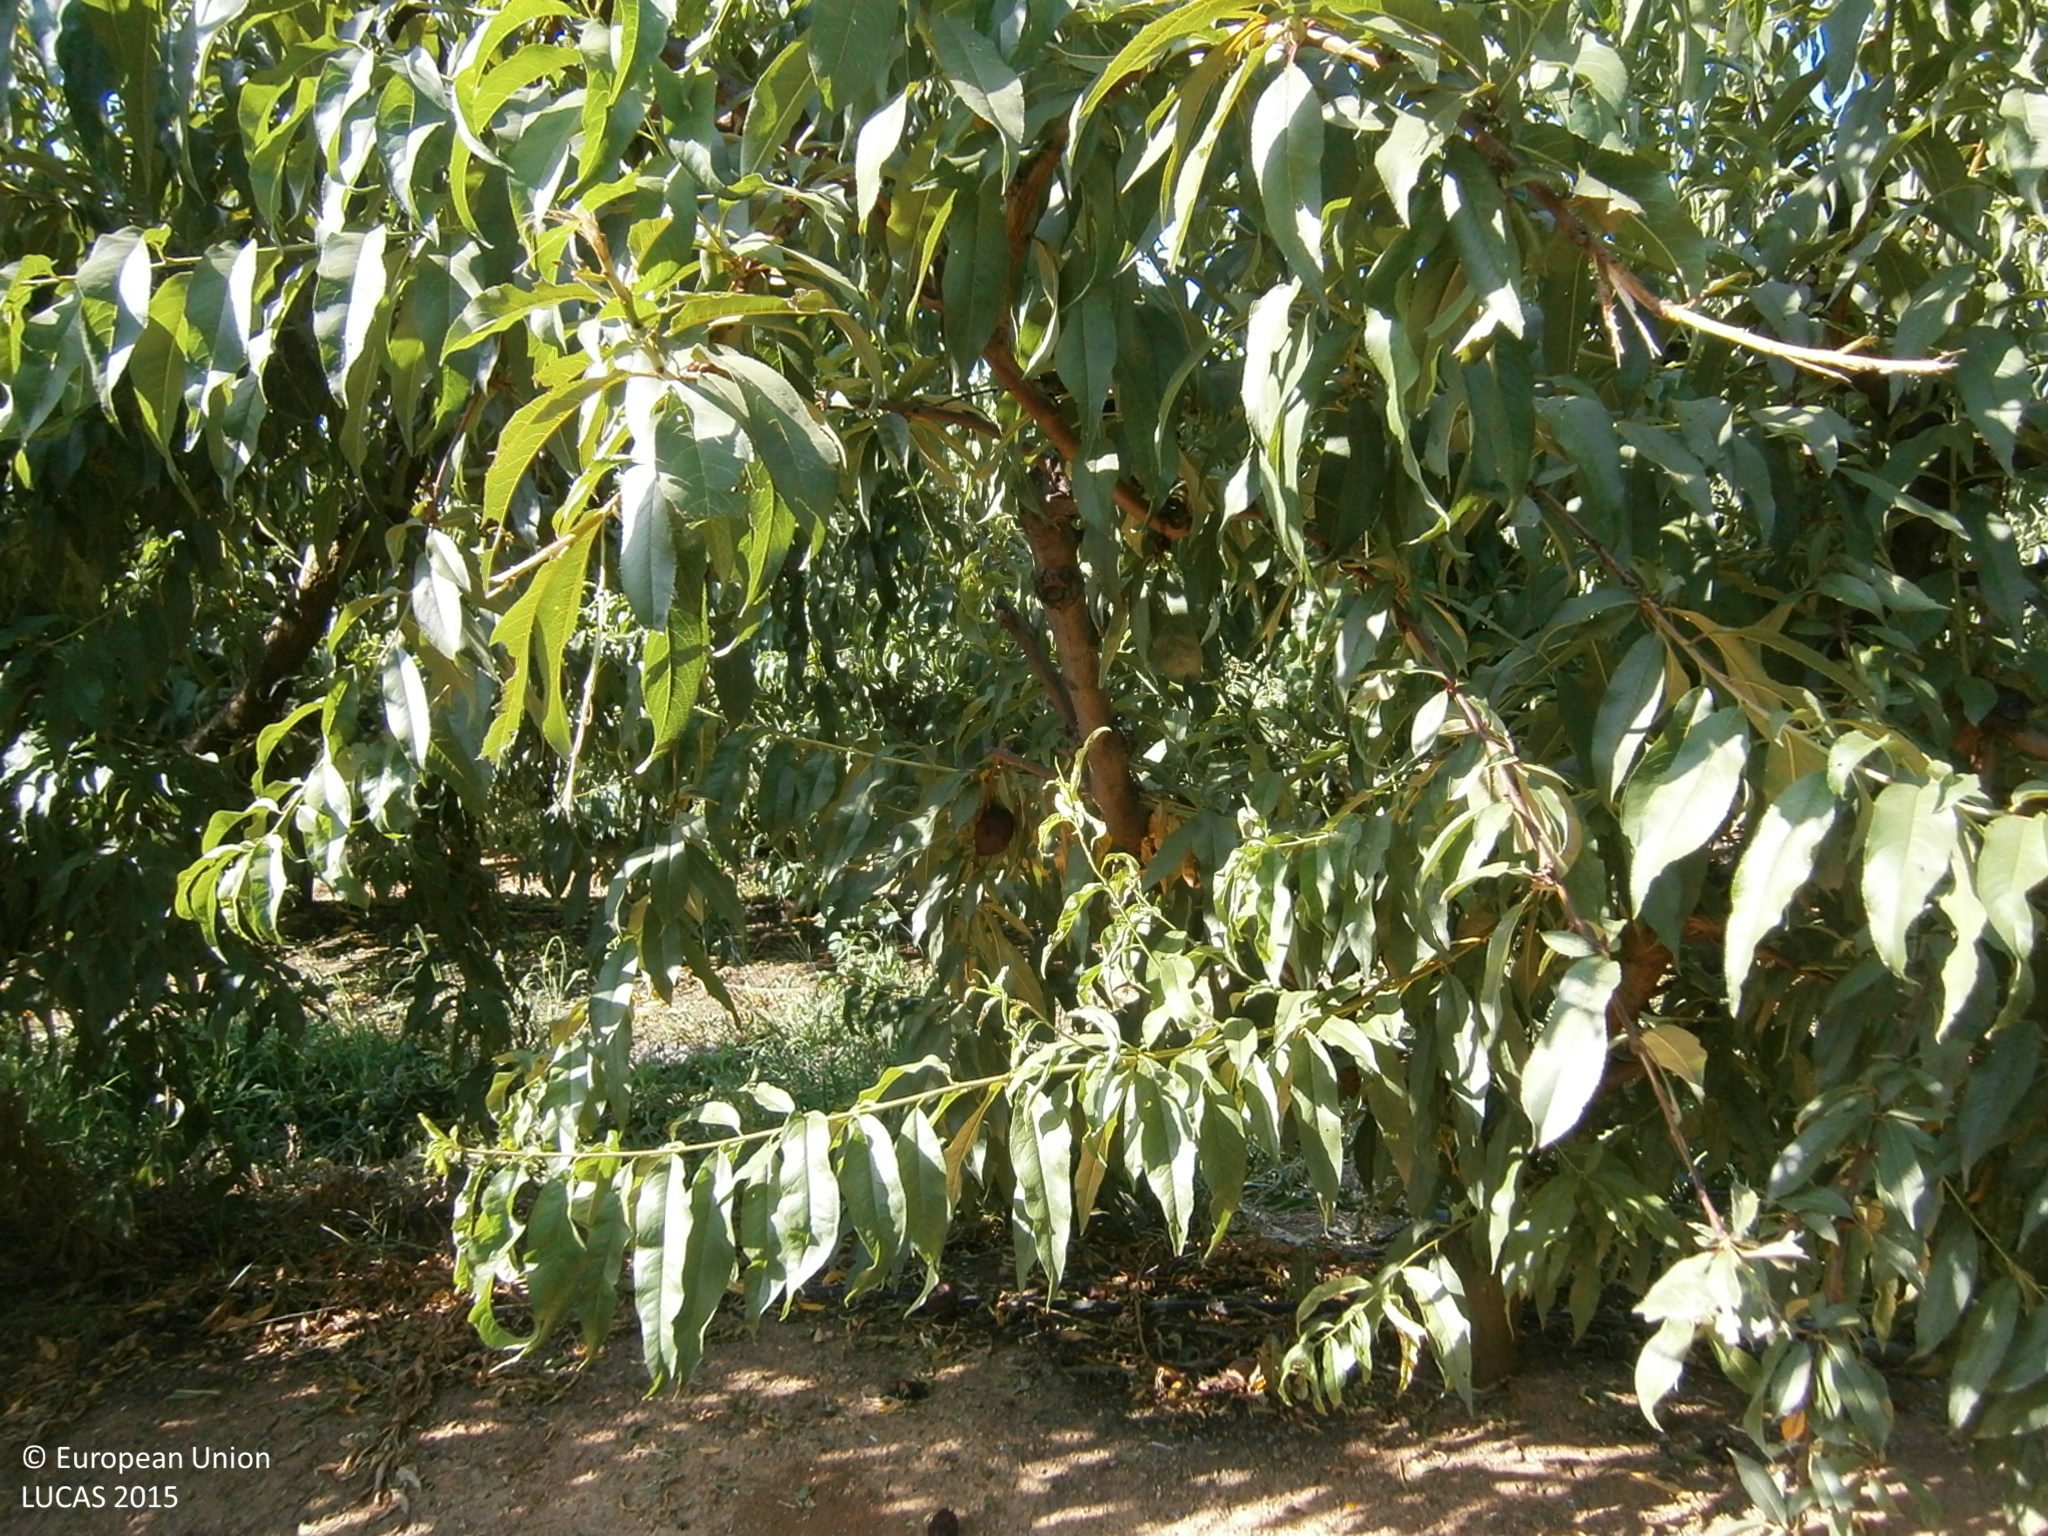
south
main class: Cropland
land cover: Other fruit trees and berries
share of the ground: 25 - 50 %
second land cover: Spontaneously vegetated surfaces
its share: 25 - 50 %
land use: Agriculture (excluding fallow land and kitchen gardens)
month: July
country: ES
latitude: 38.9326
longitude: -6.9235
